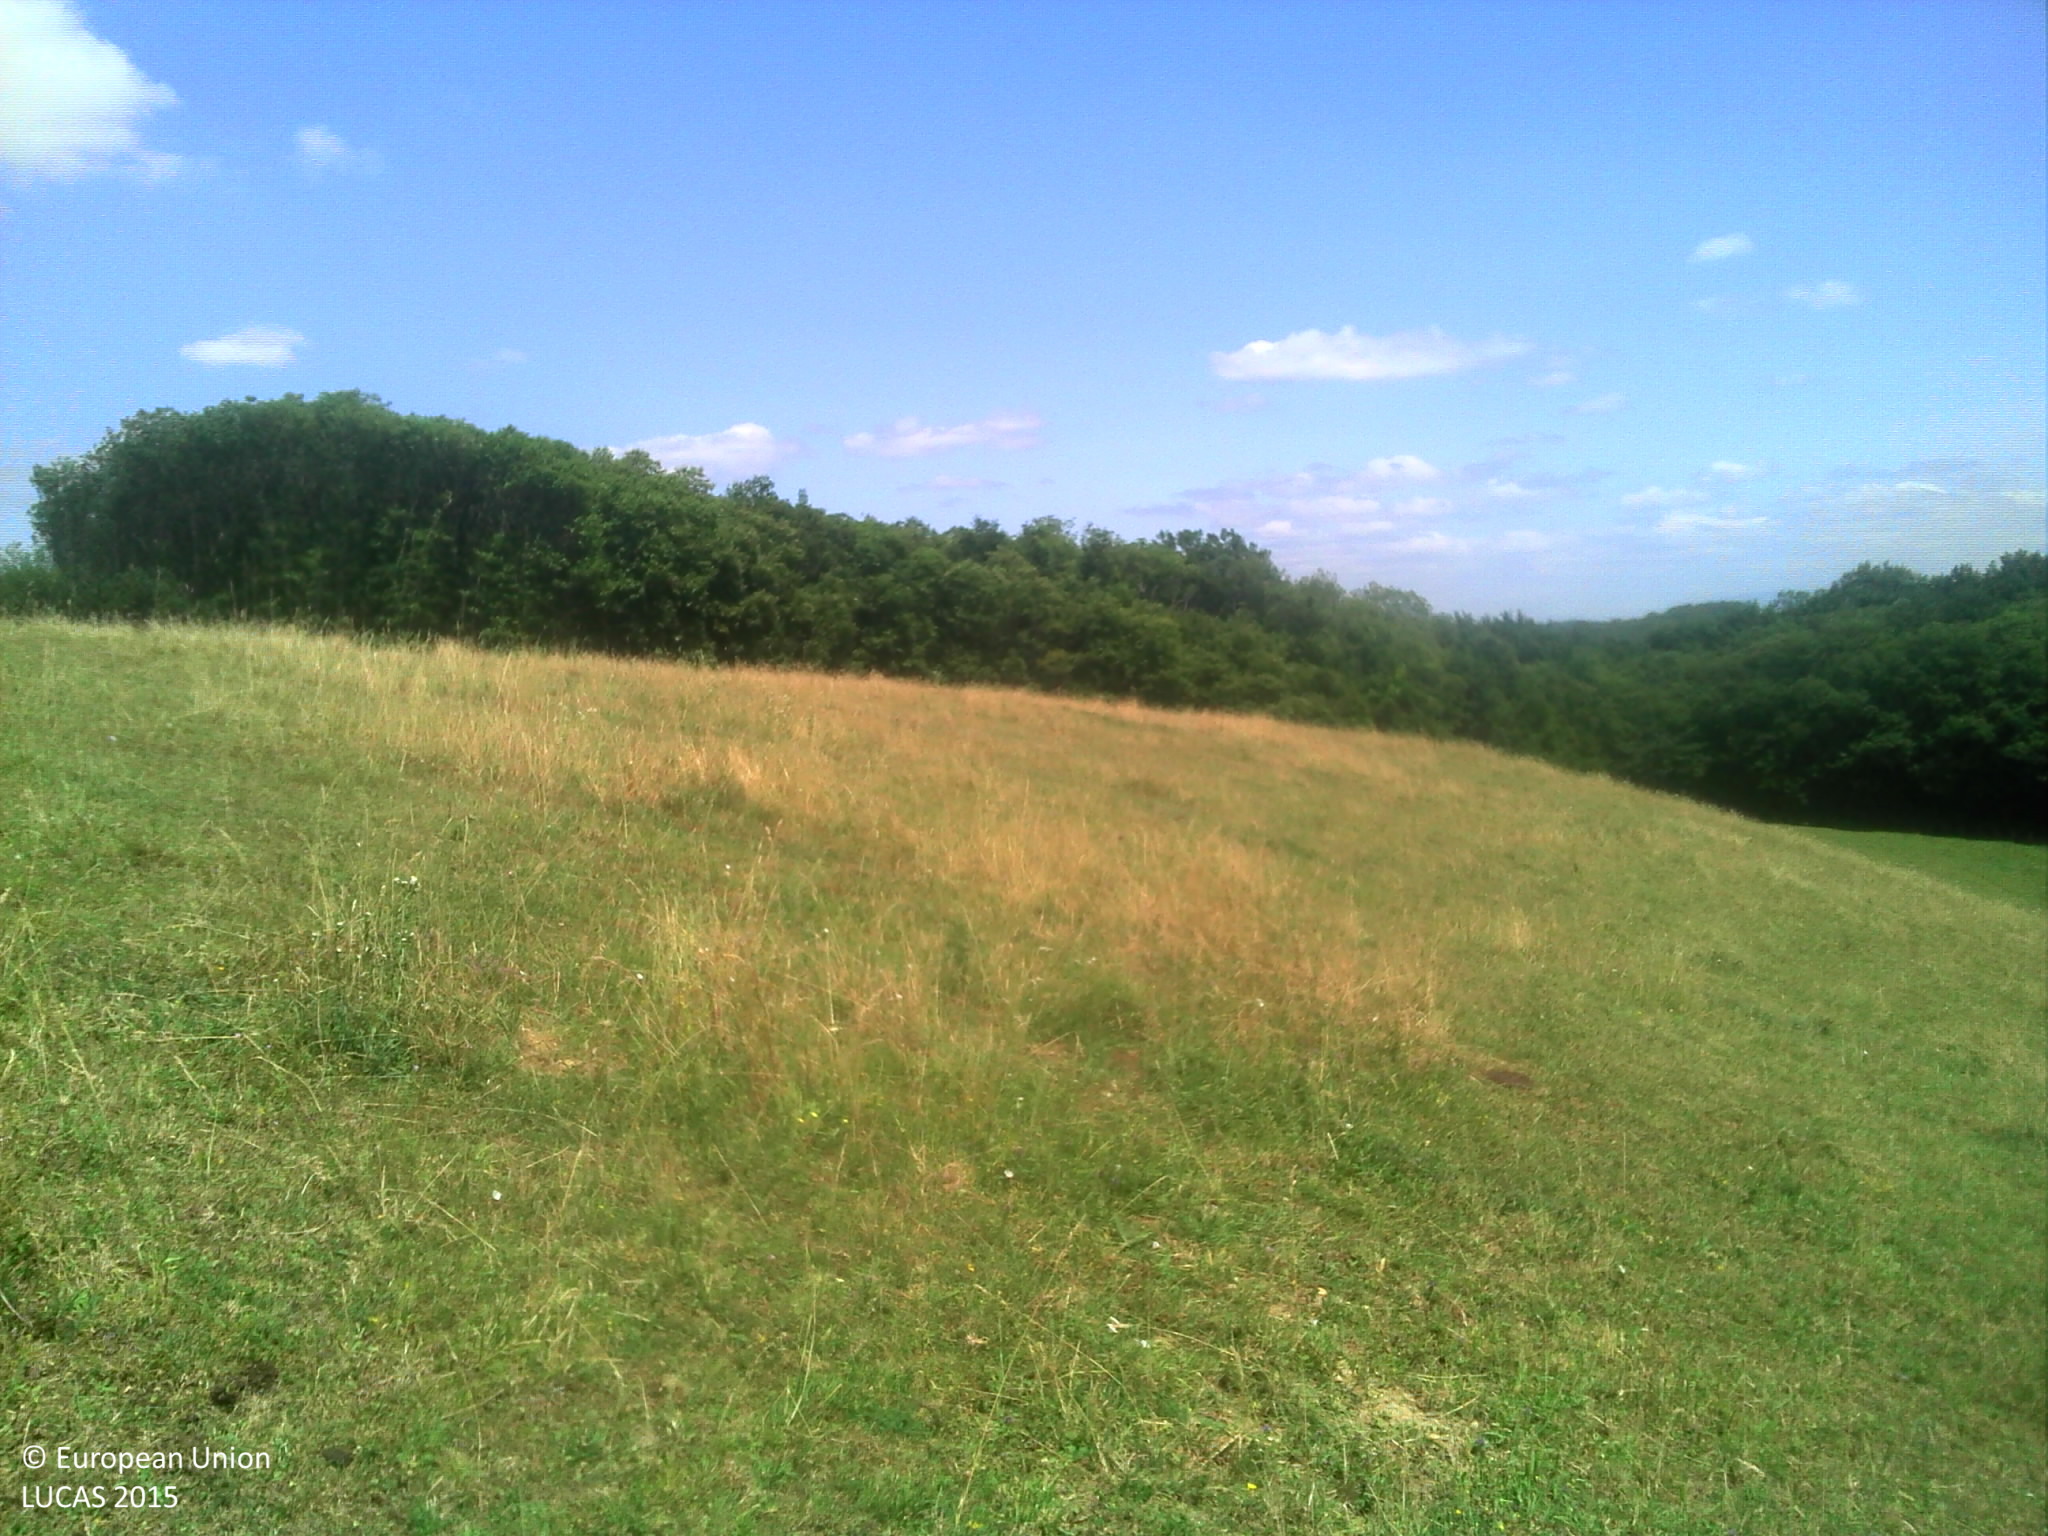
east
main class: Grassland
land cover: Grassland without tree/shrub cover
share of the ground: > 75 %
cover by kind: herbaceous plants 100 %
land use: Agriculture (excluding fallow land and kitchen gardens)
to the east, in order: Grassland without tree/shrub cover; Fences; Grassland without tree/shrub cover; Fences; Tracks; Broadleaved woodland
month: July
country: FR
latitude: 45.5206
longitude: 5.1780
